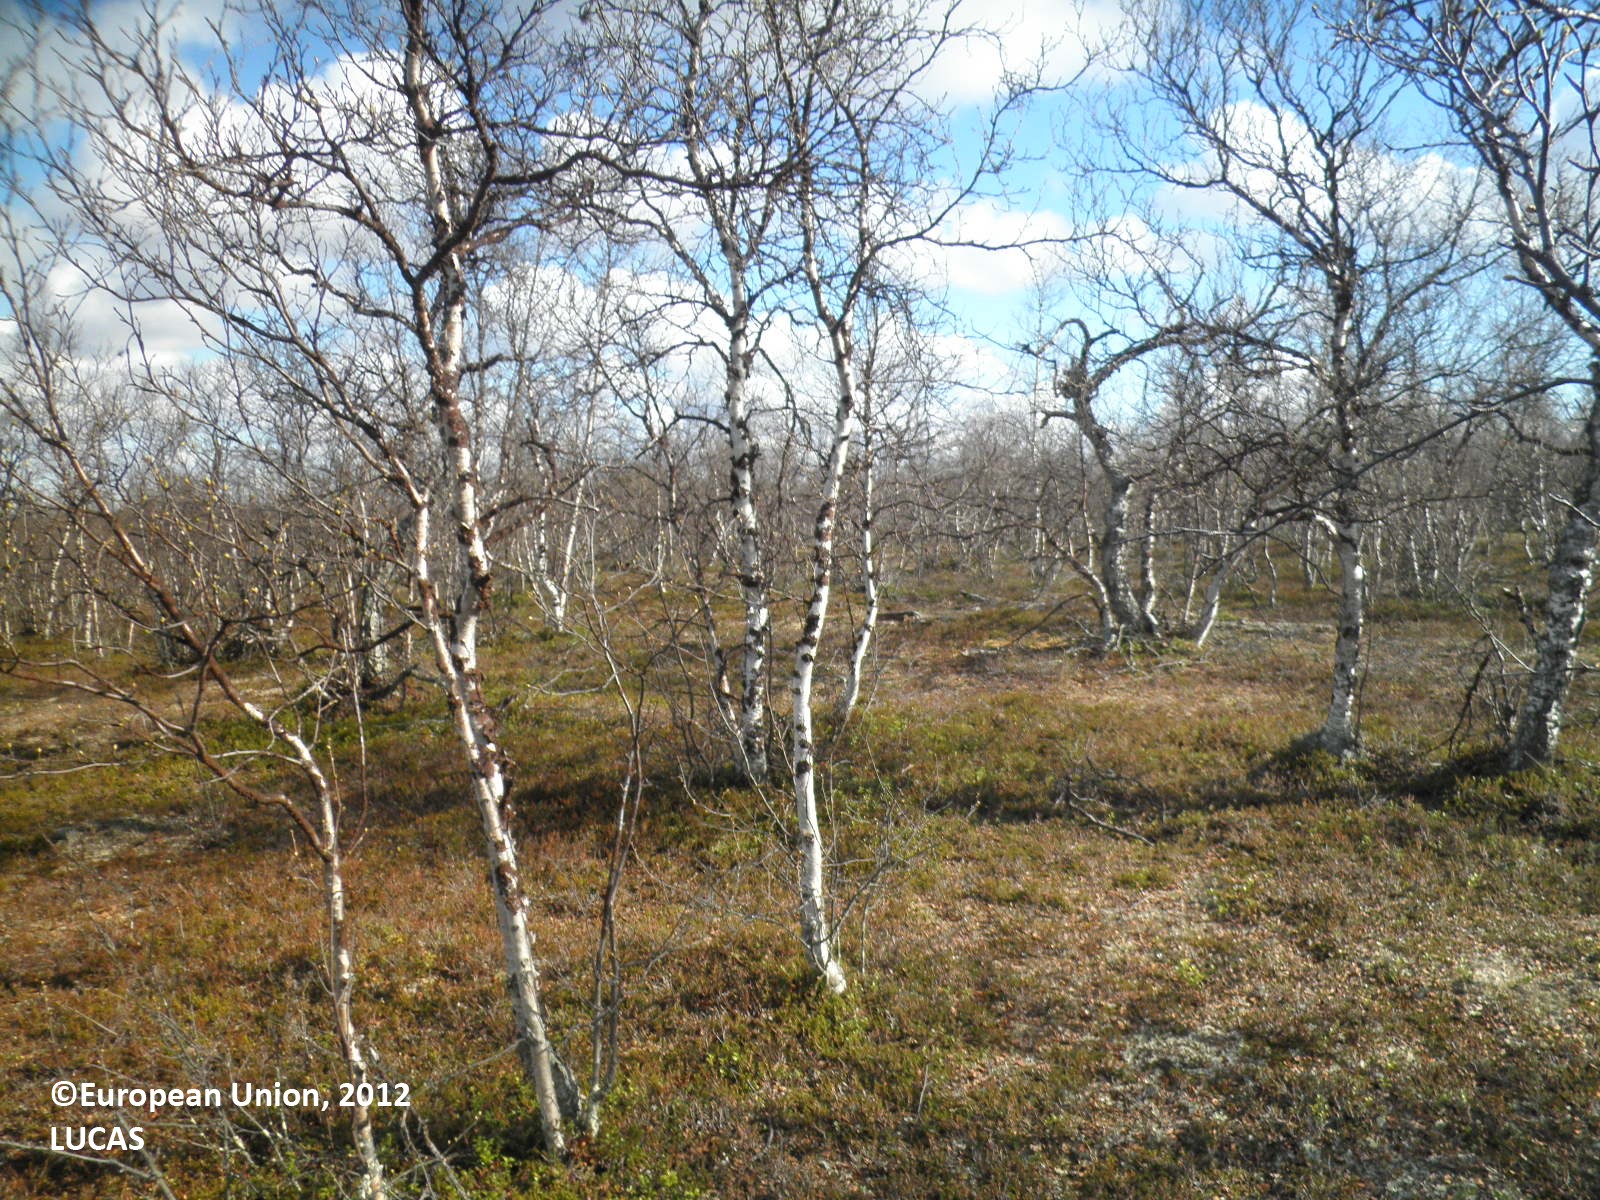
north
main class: Woodland
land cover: Broadleaved woodland
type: boreal forest
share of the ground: > 75 %
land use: Forestry
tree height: > 5 m
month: May
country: FI
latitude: 69.5095
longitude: 27.2295
